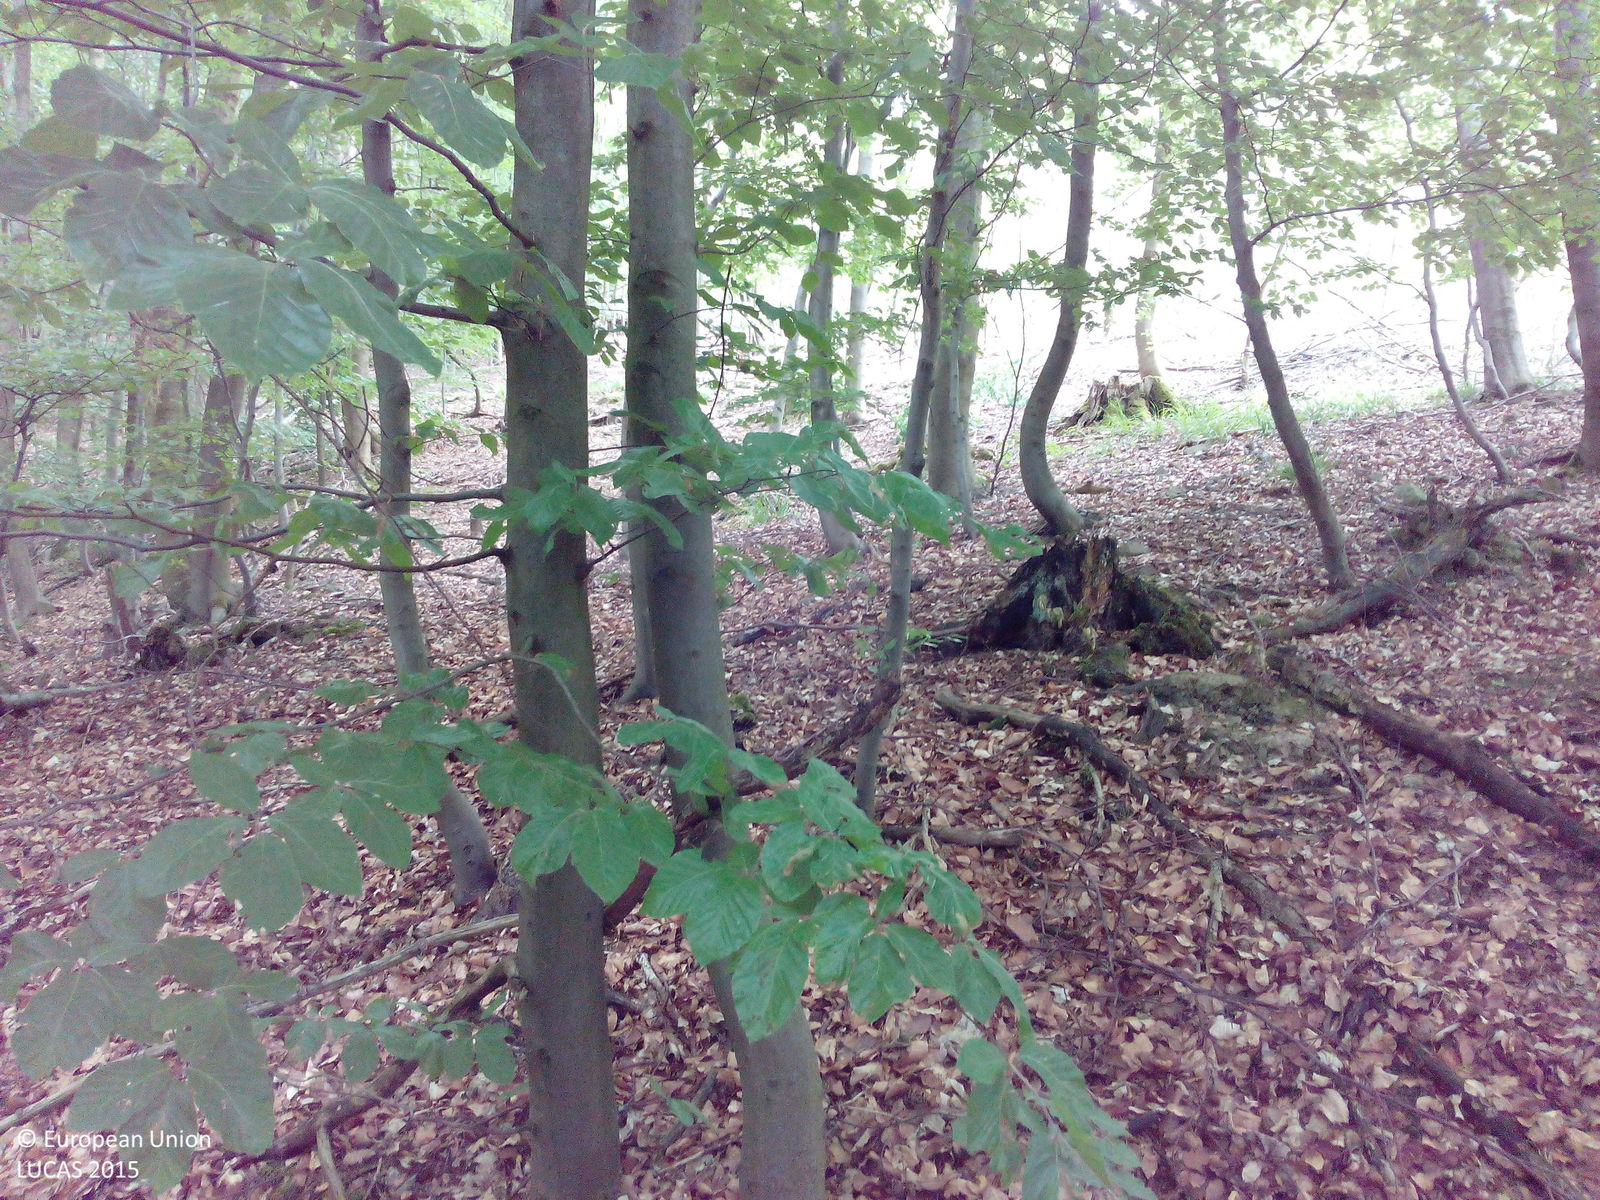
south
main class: Woodland
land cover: Broadleaved woodland
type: beech forest
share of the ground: > 75 %
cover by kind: broadleaved forest trees 95 %, unconsolidated bare surface 5 %
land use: Forestry
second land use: Amenities, museums, leisure
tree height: > 5 m
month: May
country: DE
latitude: 51.9457
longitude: 10.2763
